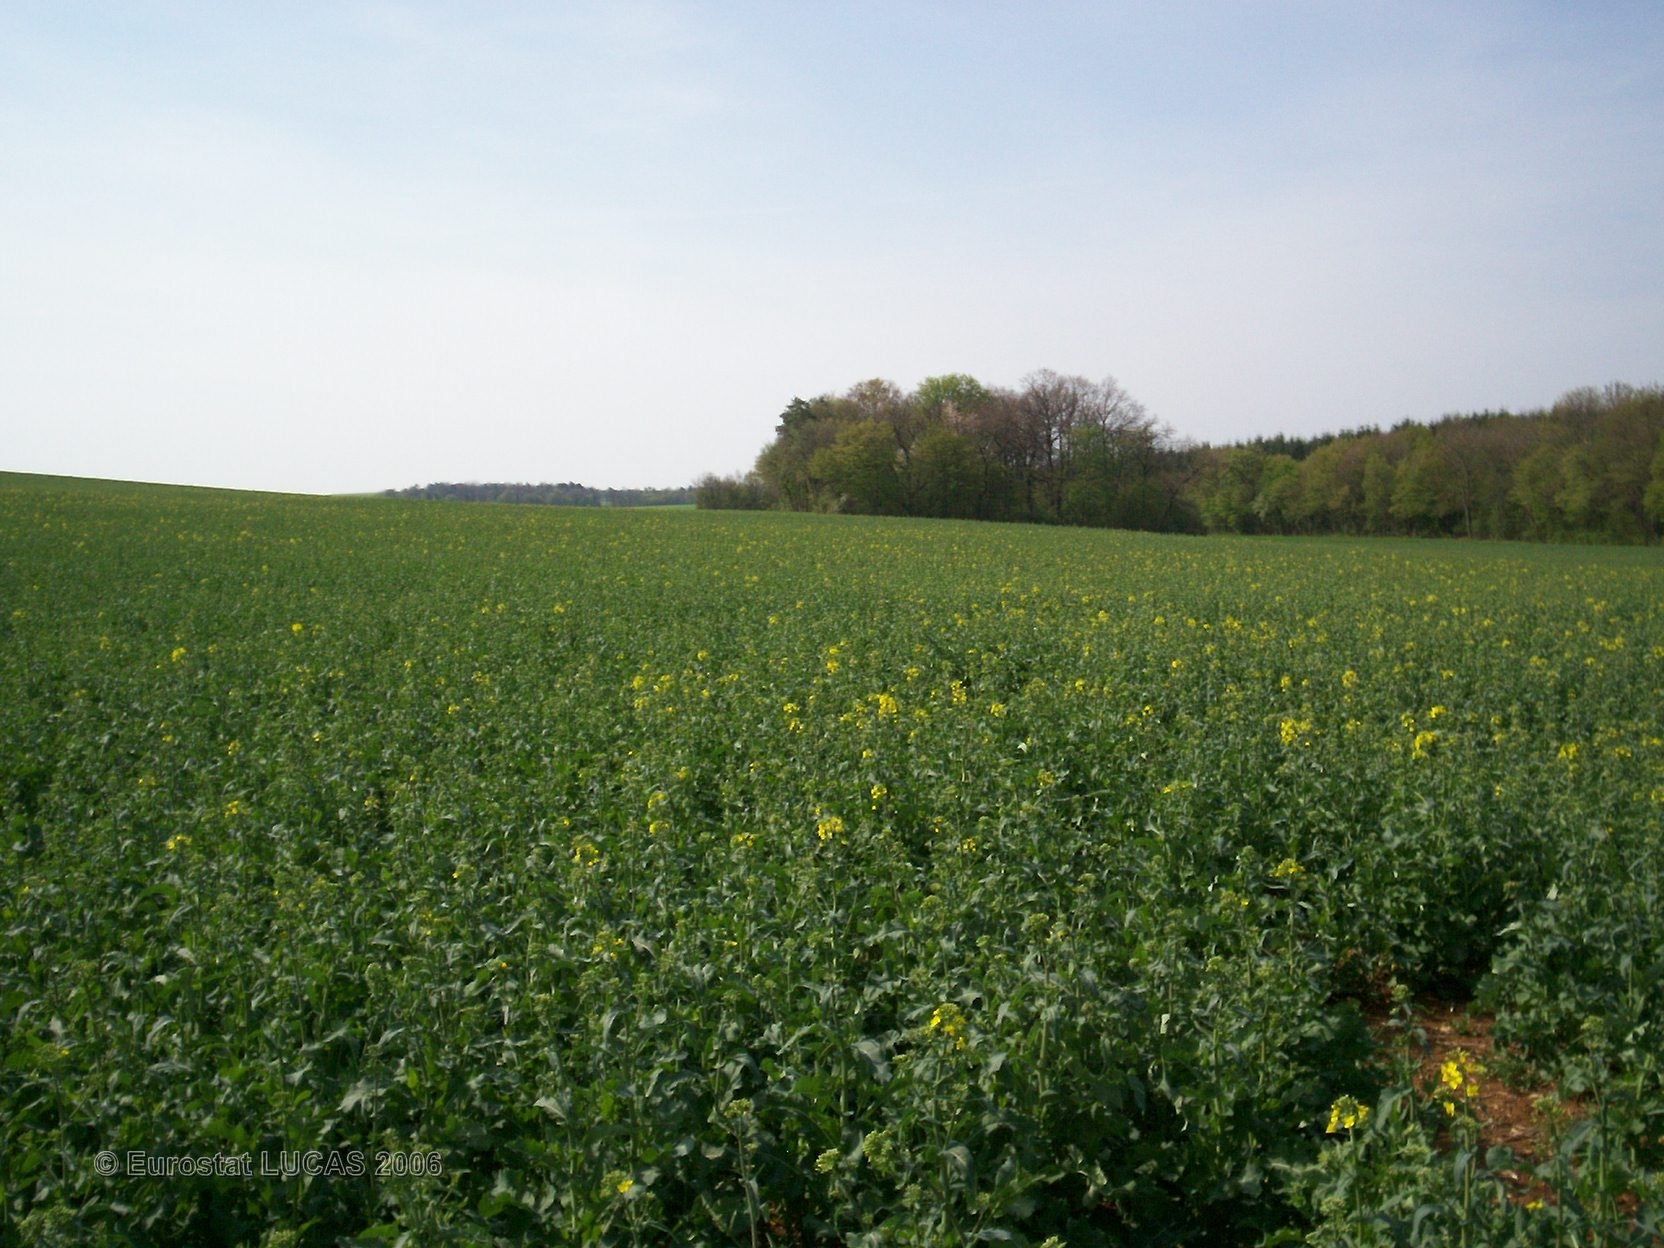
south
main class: Cropland
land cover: Rape and turnip rape
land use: Agriculture (excluding fallow land and kitchen gardens)
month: May
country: FR
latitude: 47.6035
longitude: 4.5854
